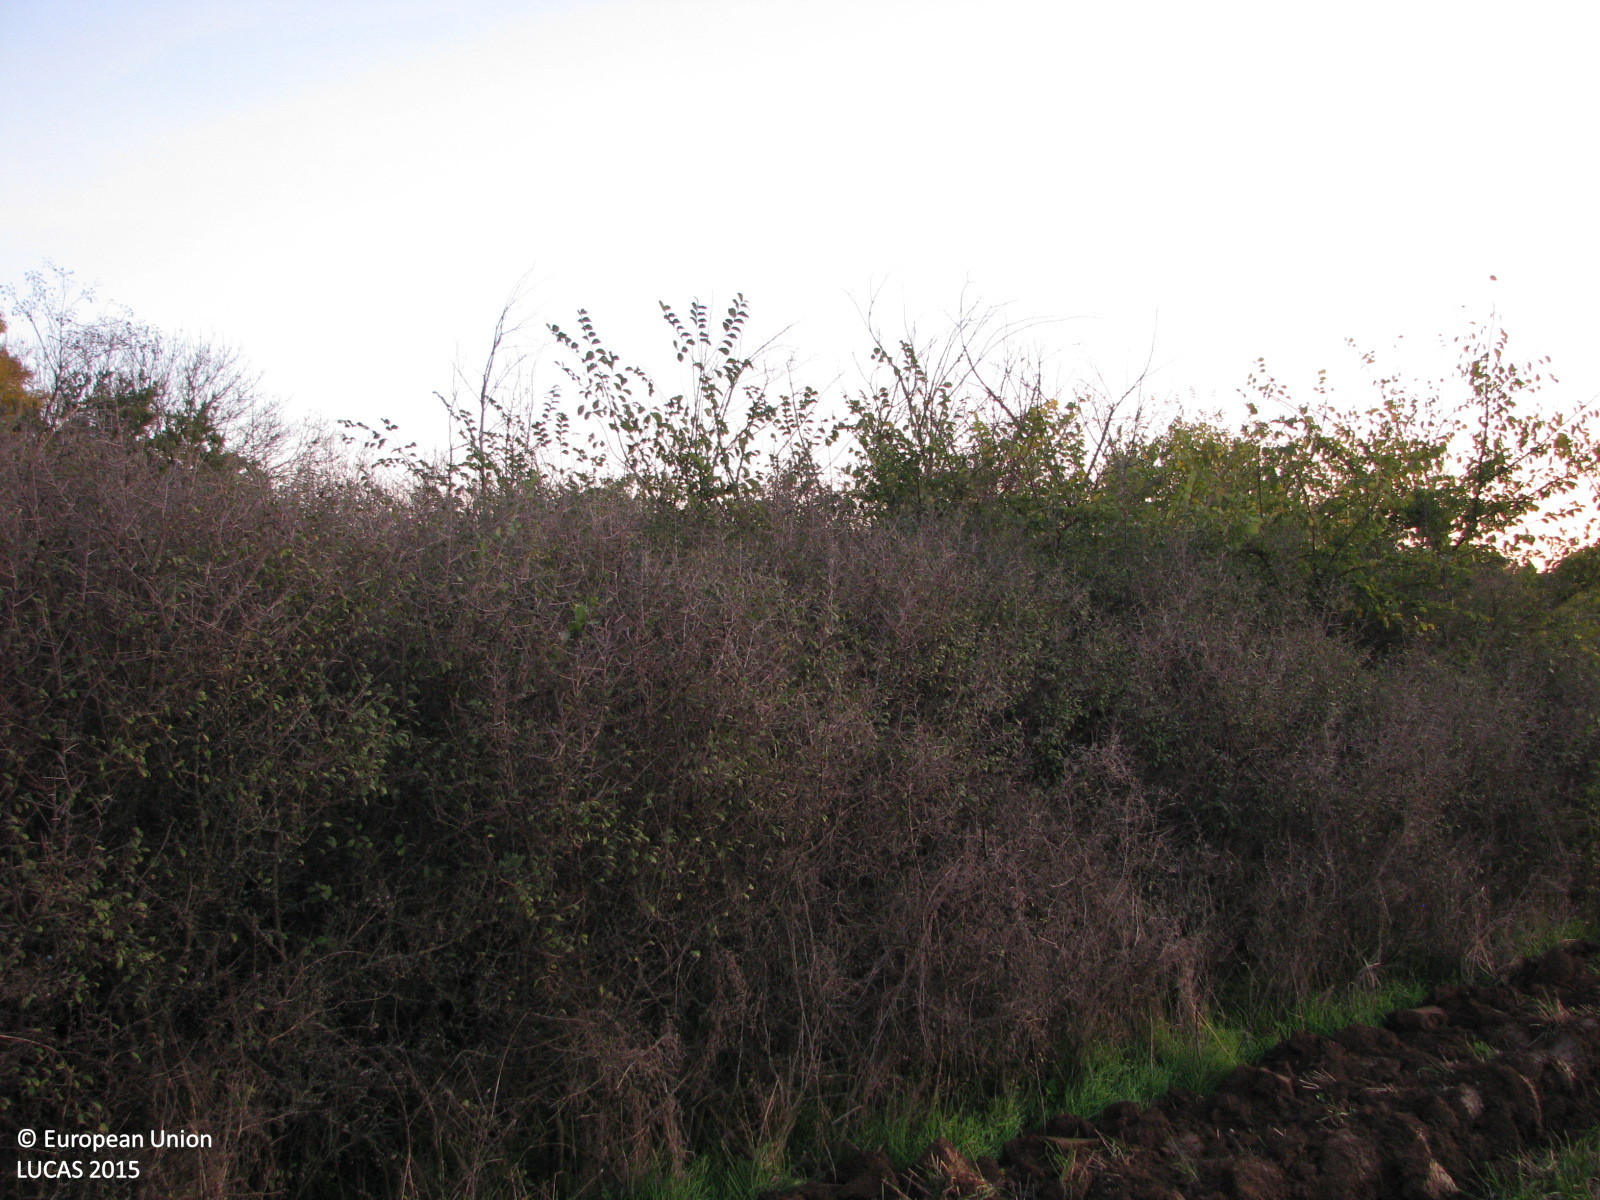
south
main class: Cropland
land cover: Common wheat
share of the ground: 10 - 25 %
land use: Agriculture (excluding fallow land and kitchen gardens)
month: October
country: BG
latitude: 42.2536
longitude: 26.7867
